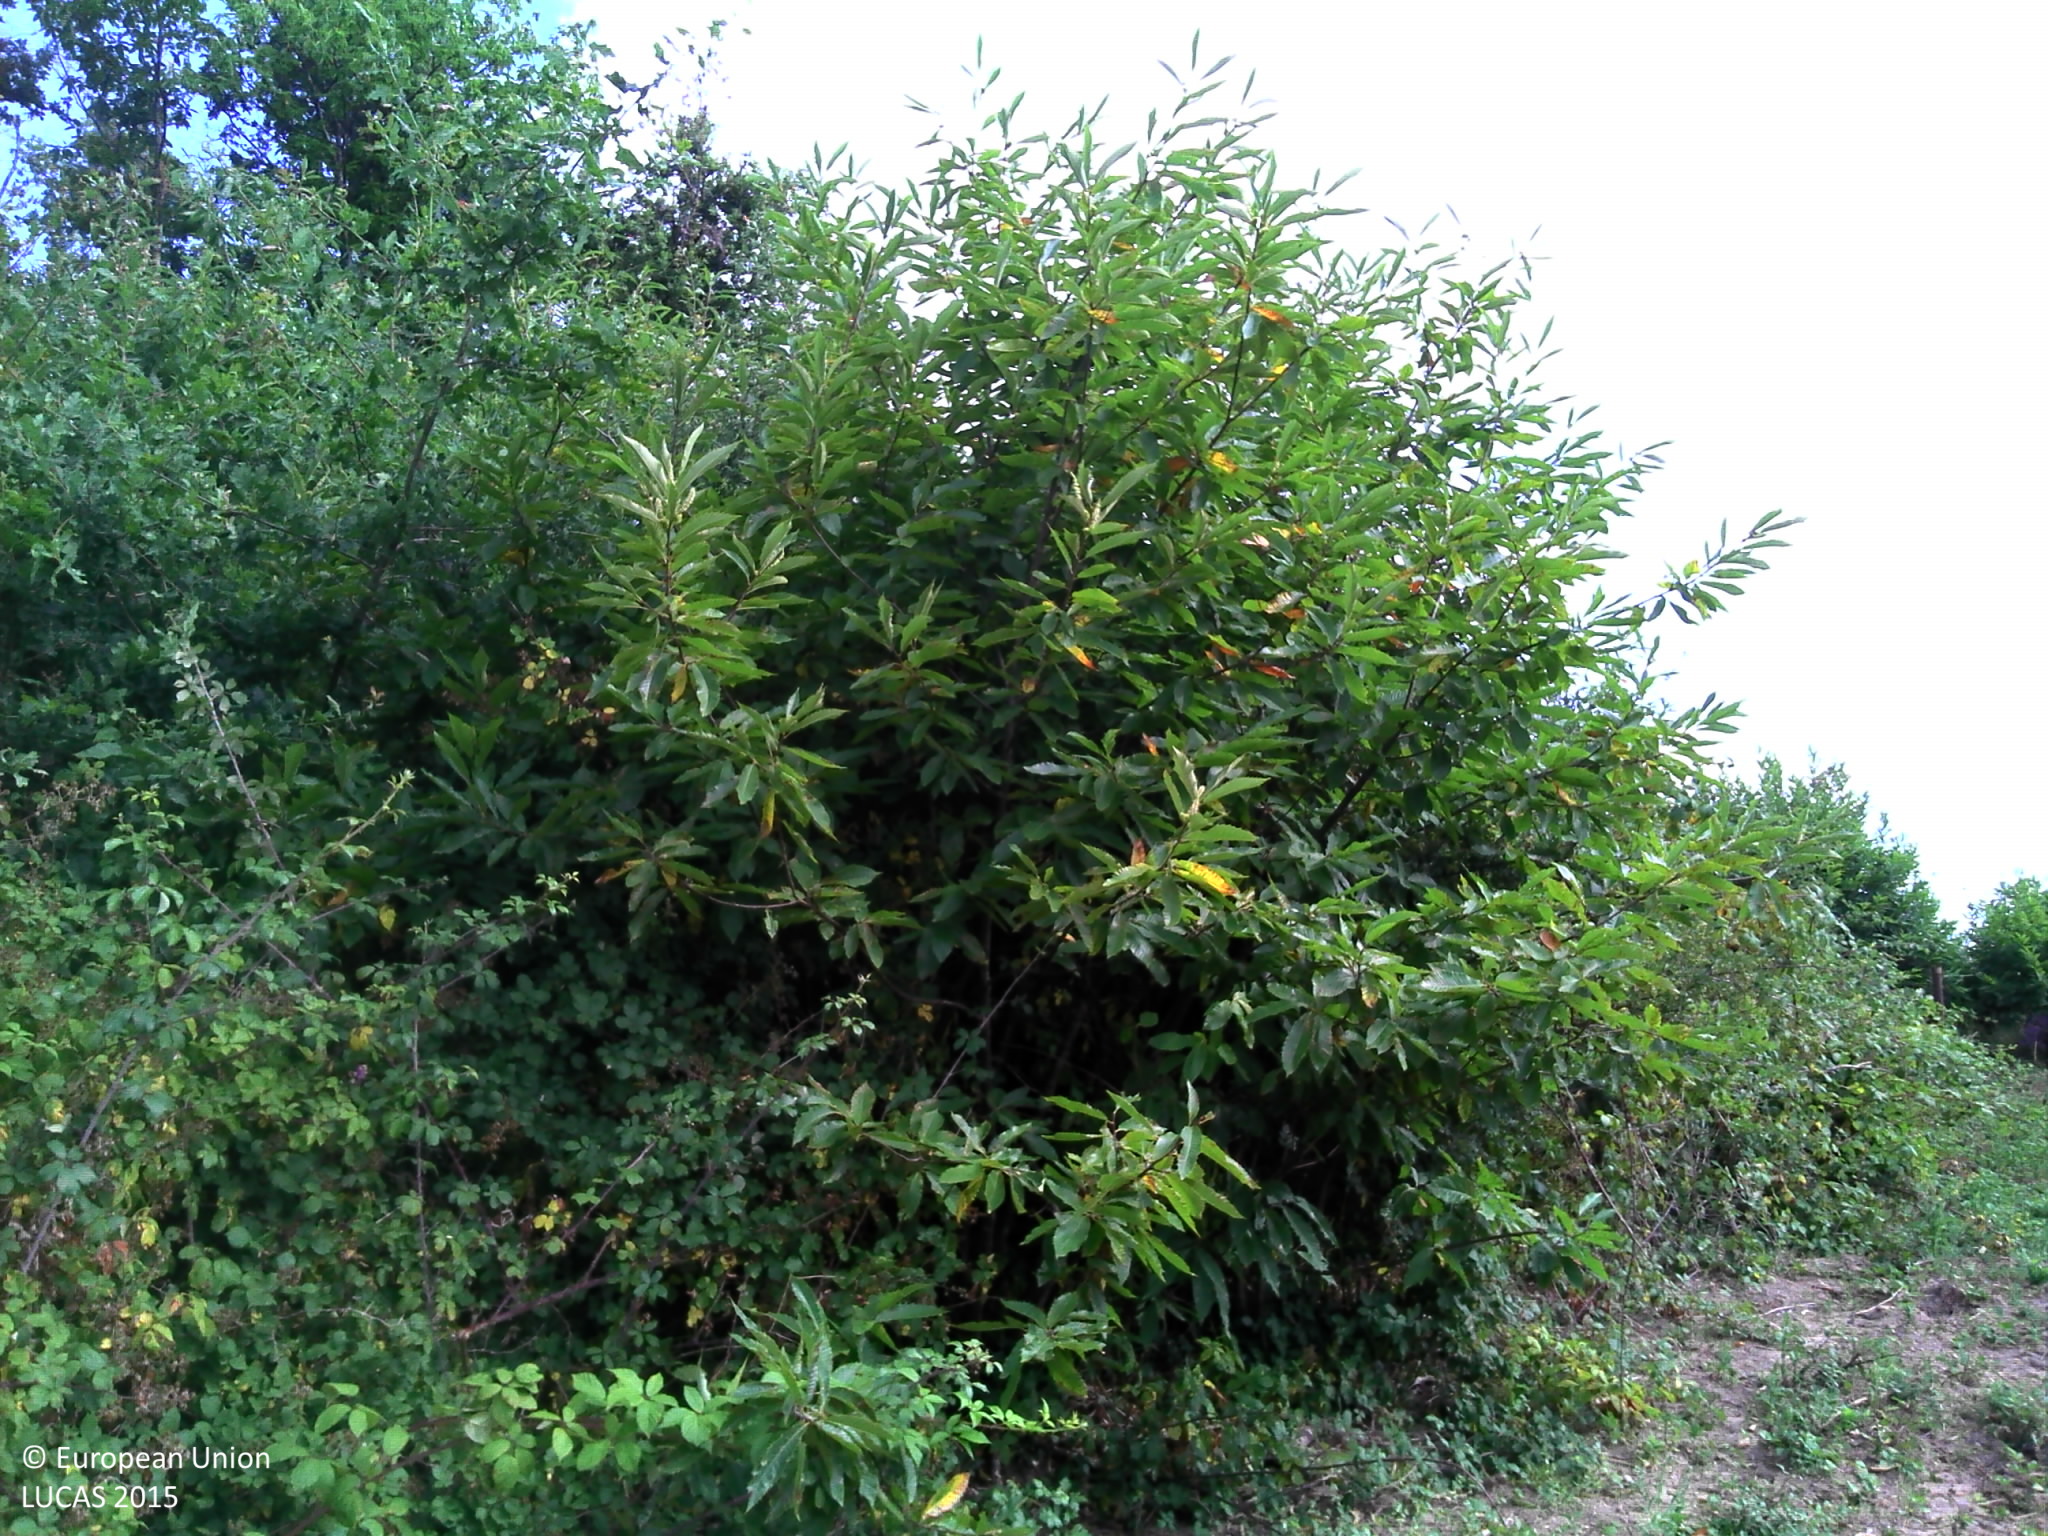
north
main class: Grassland
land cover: Spontaneously vegetated surfaces
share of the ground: > 75 %
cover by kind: herbaceous plants 95 %, shrubs 5 %
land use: Semi-natural and natural areas not in use
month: July
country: FR
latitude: 45.3352
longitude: -0.5743
